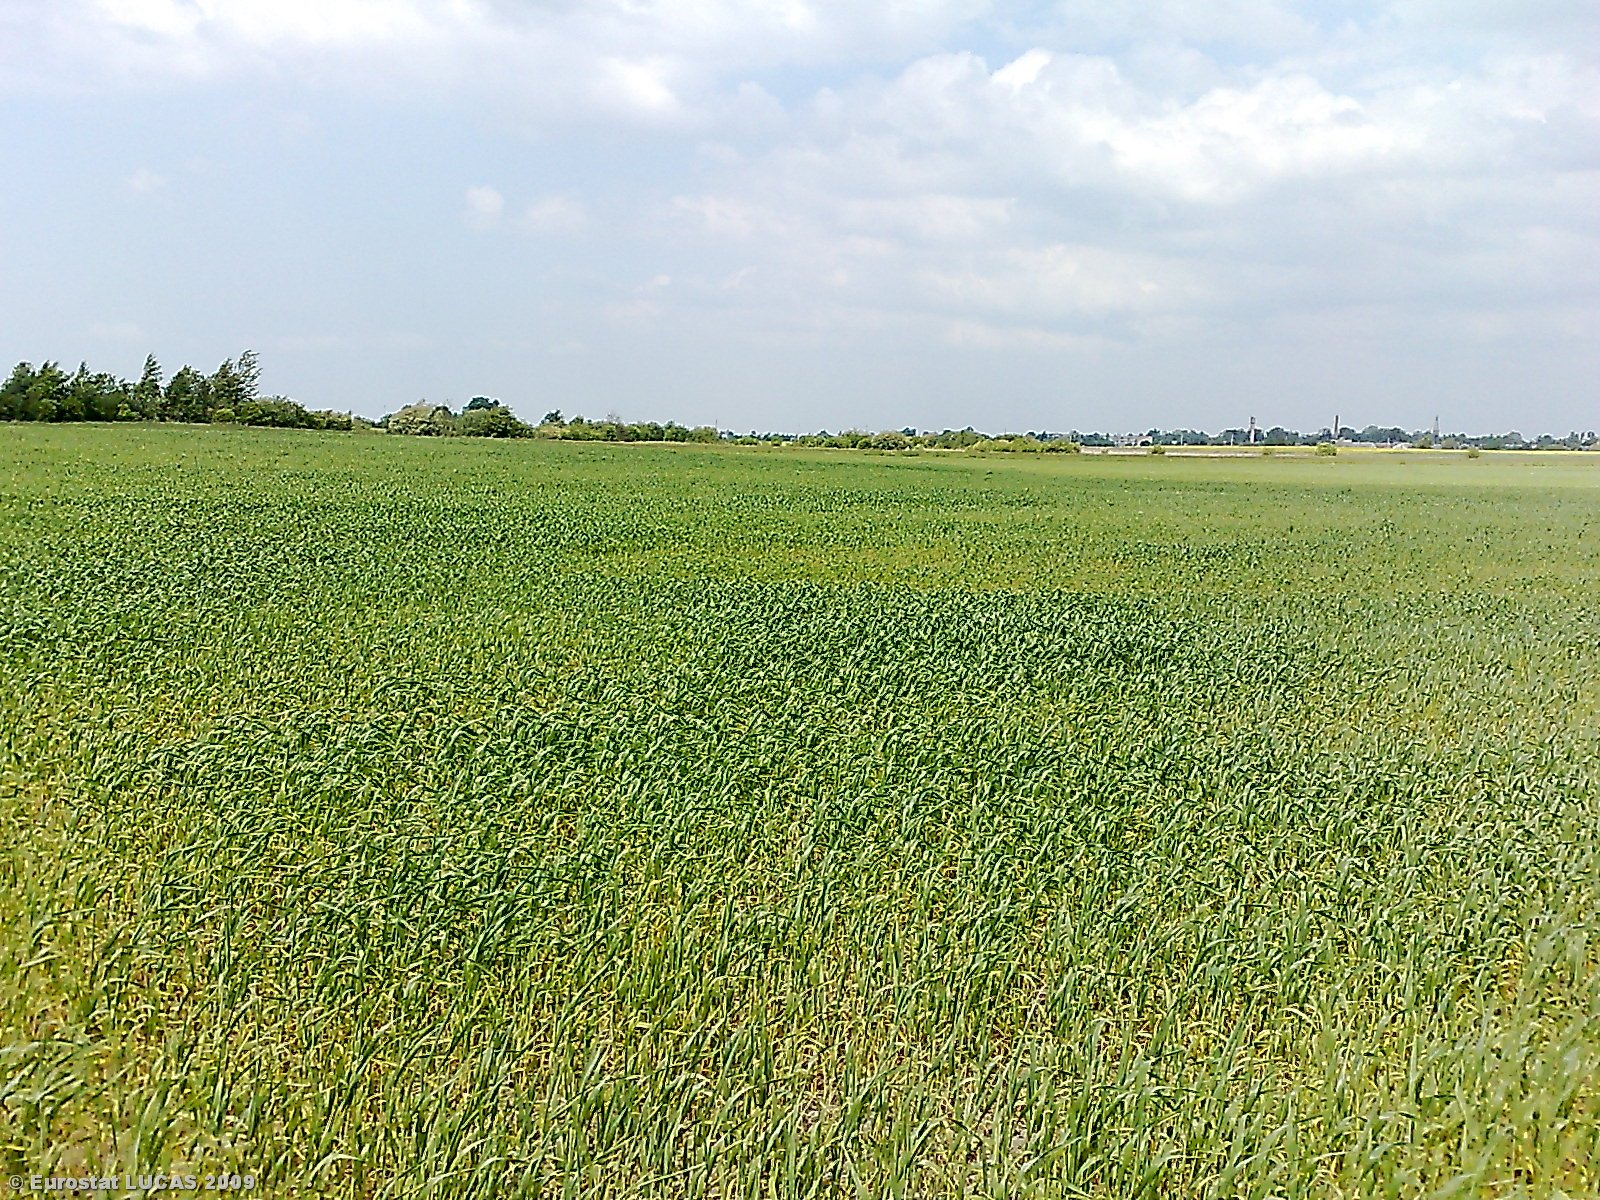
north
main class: Cropland
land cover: Common wheat
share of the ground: > 75 %
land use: Agriculture (excluding fallow land and kitchen gardens)
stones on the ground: < 10 %
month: May
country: LT
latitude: 56.2577
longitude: 23.9845
